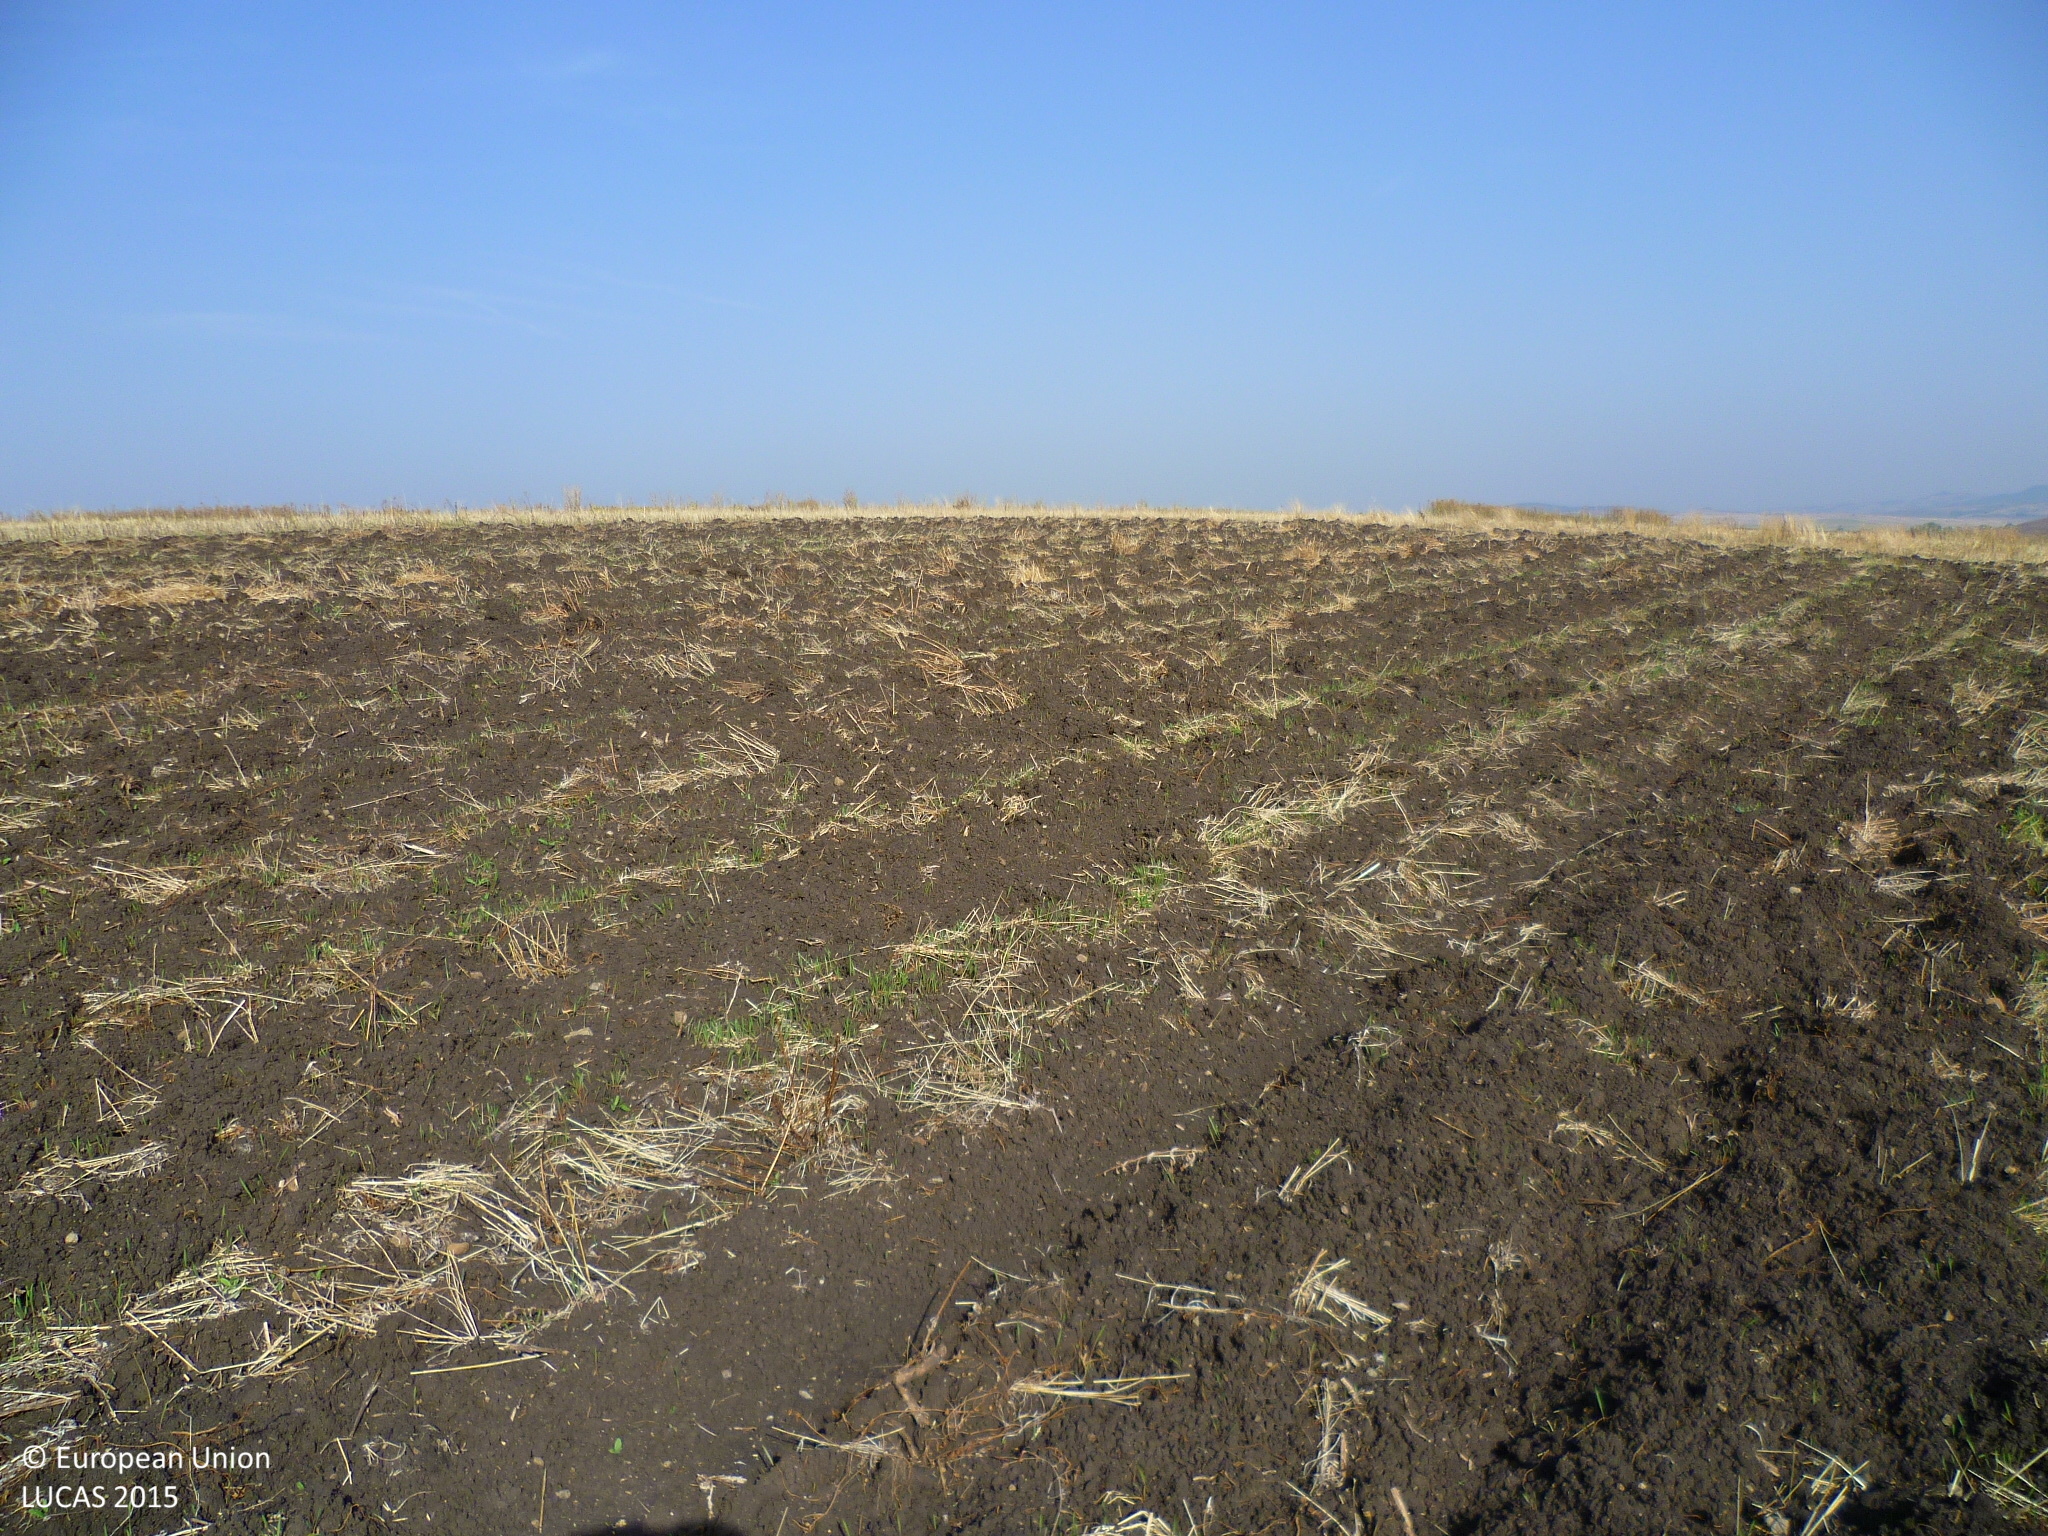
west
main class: Cropland
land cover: Rape and turnip rape
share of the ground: < 10 %
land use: Agriculture (excluding fallow land and kitchen gardens)
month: September
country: BG
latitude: 42.6561
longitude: 22.9720
